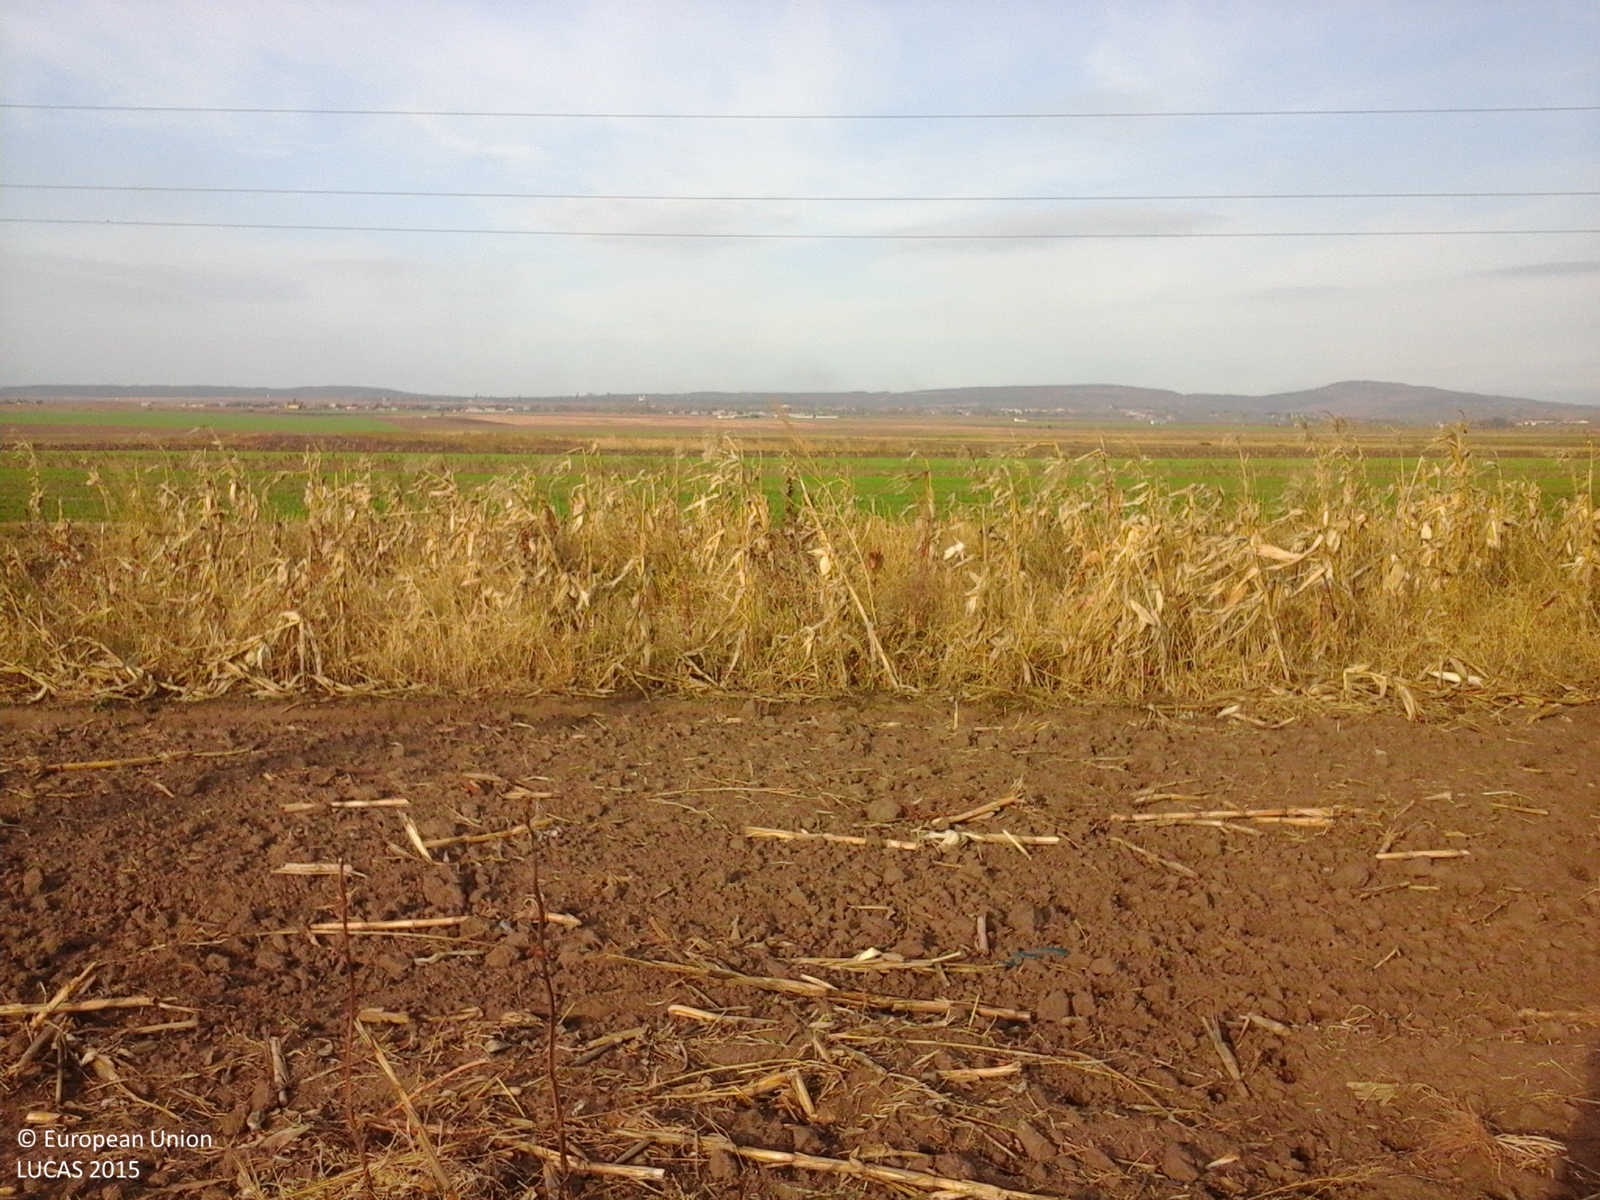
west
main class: Cropland
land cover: Lucerne
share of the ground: > 75 %
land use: Agriculture (excluding fallow land and kitchen gardens)
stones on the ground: < 10 %
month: October
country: RO
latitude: 45.4775
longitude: 27.0916
